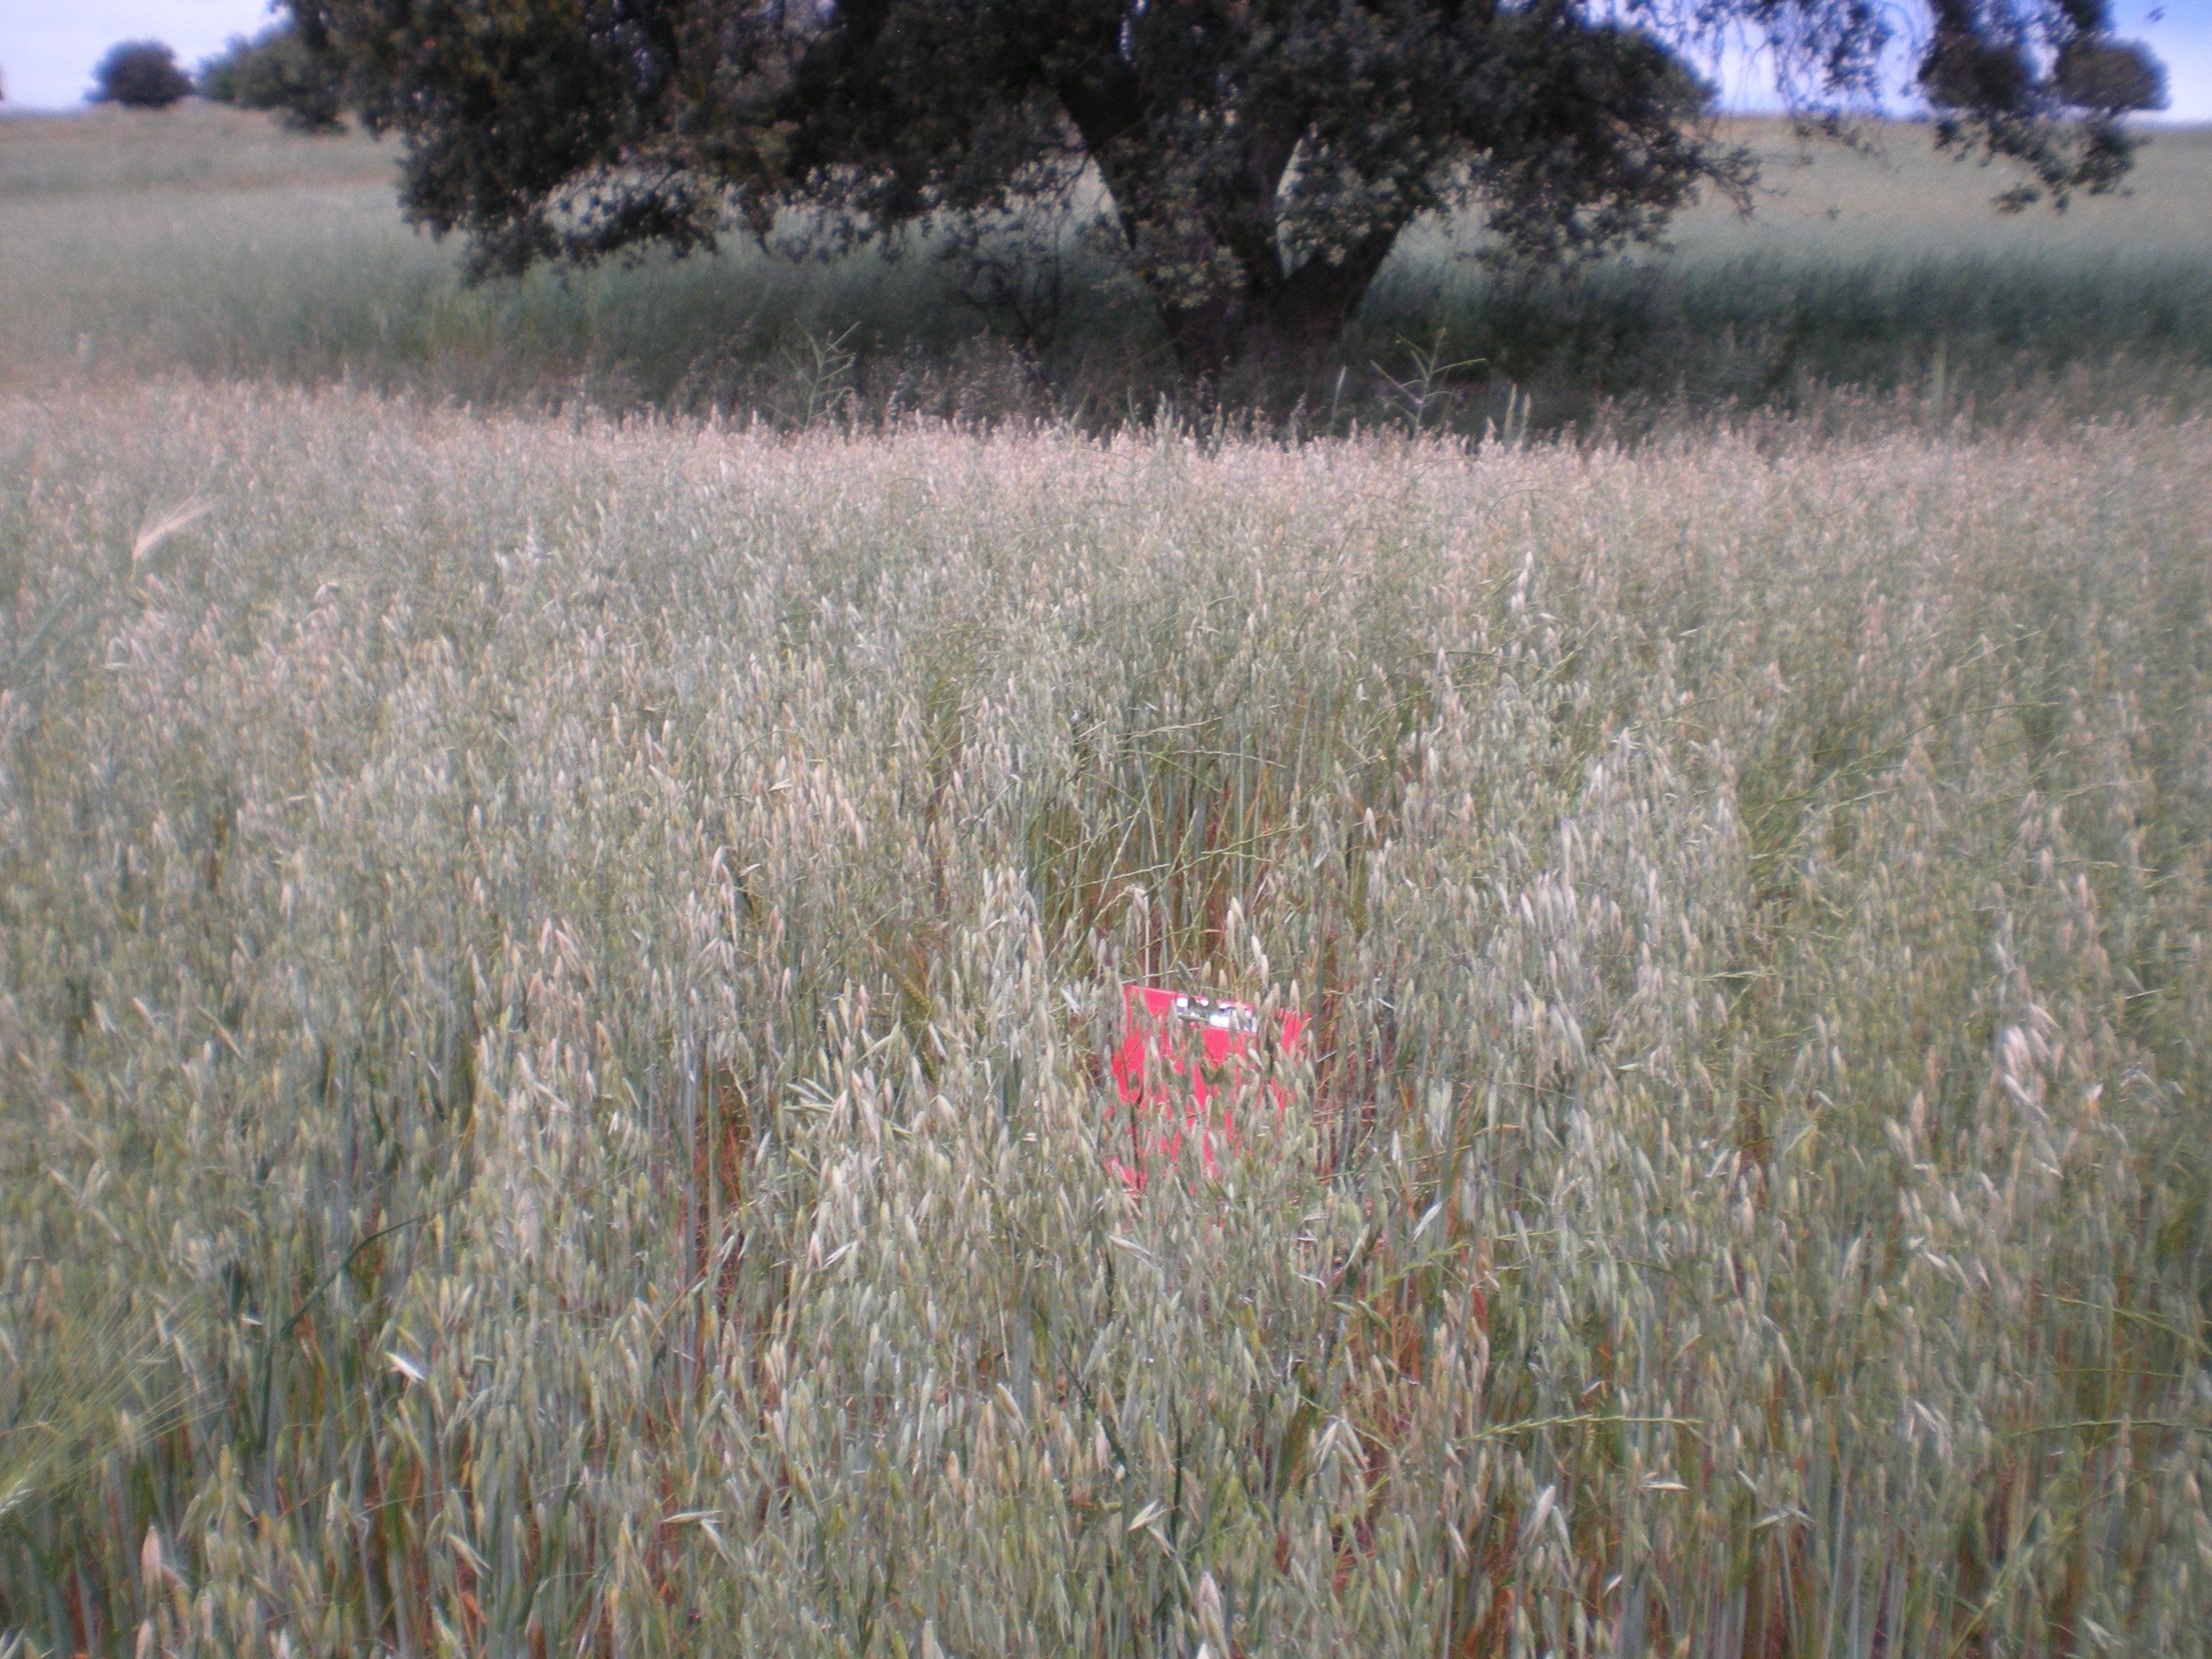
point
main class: Cropland
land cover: Oats
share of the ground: > 75 %
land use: Agriculture (excluding fallow land and kitchen gardens)
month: May
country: ES
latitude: 38.7088
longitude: -3.2217
